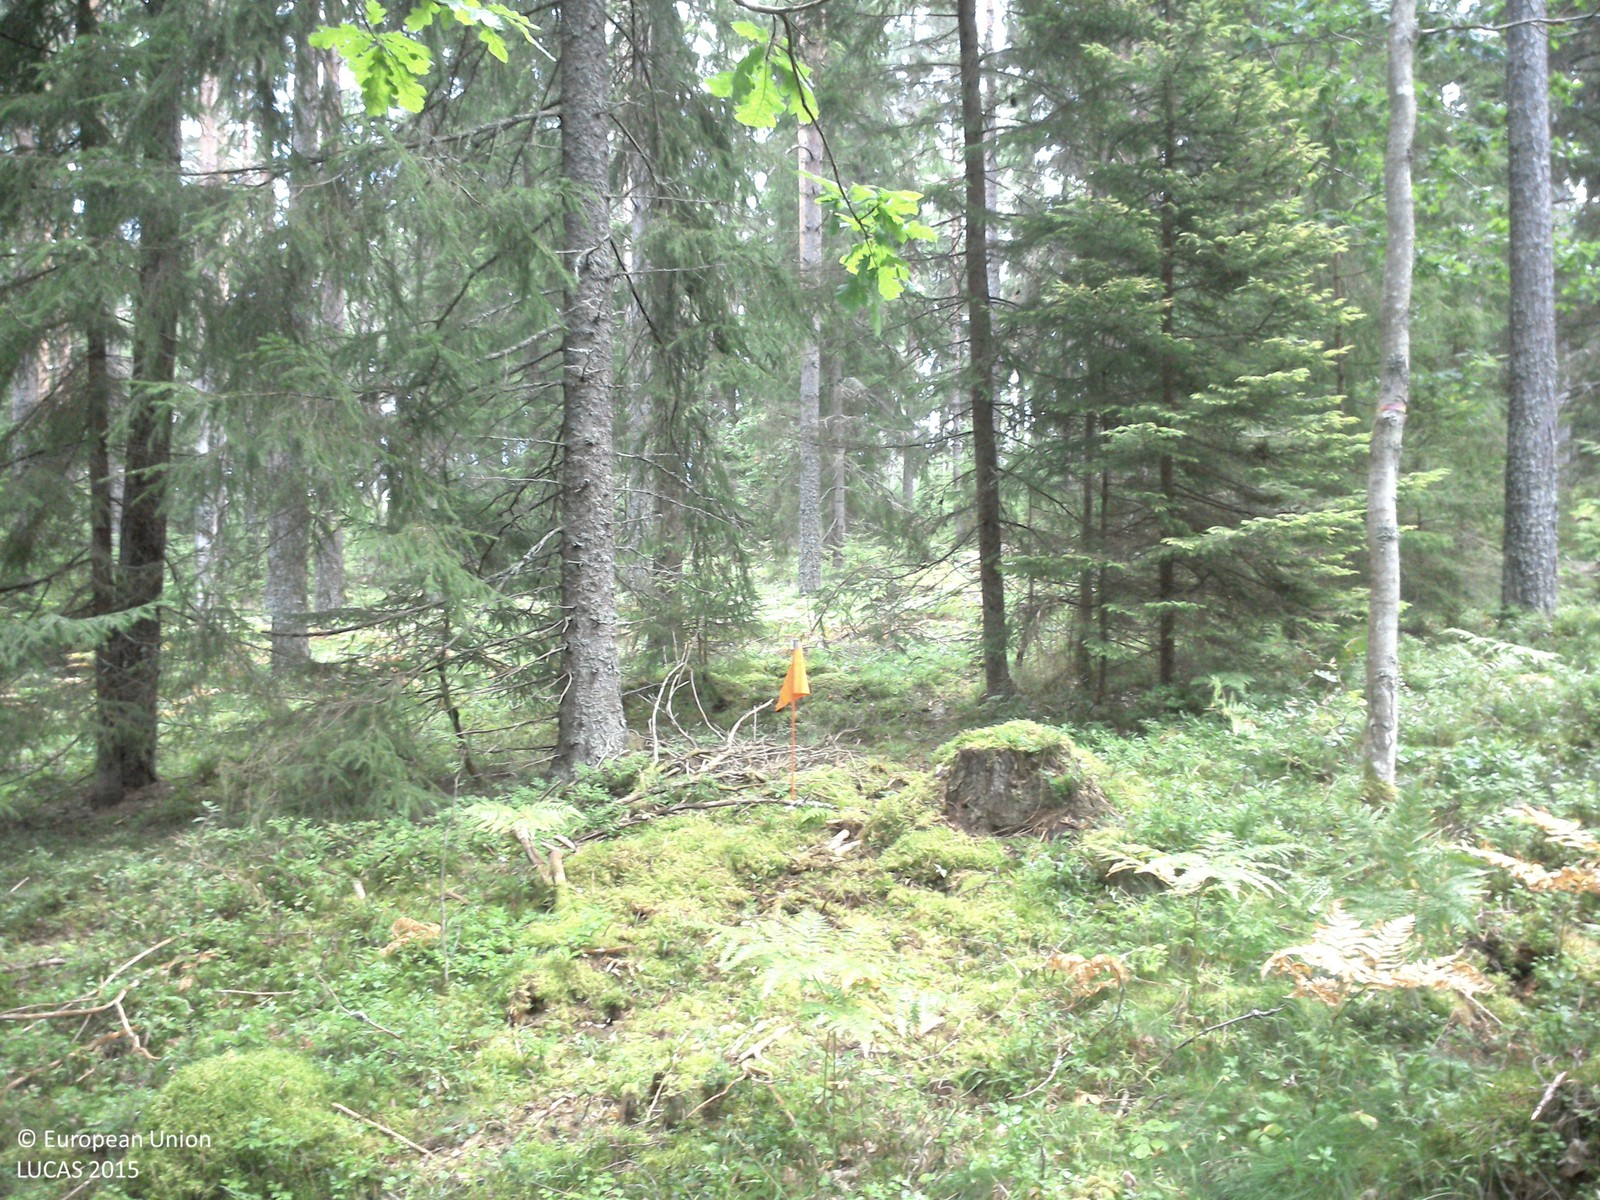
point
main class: Woodland
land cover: Pine dominated coniferous woodland
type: boreal forest
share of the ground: 25 - 50 %
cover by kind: coniferous forest trees 45 %, lichens and mosses 45 %, herbaceous plants 10 %
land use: Forestry
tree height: > 5 m
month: August
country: SE
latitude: 57.8113
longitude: 15.2300
